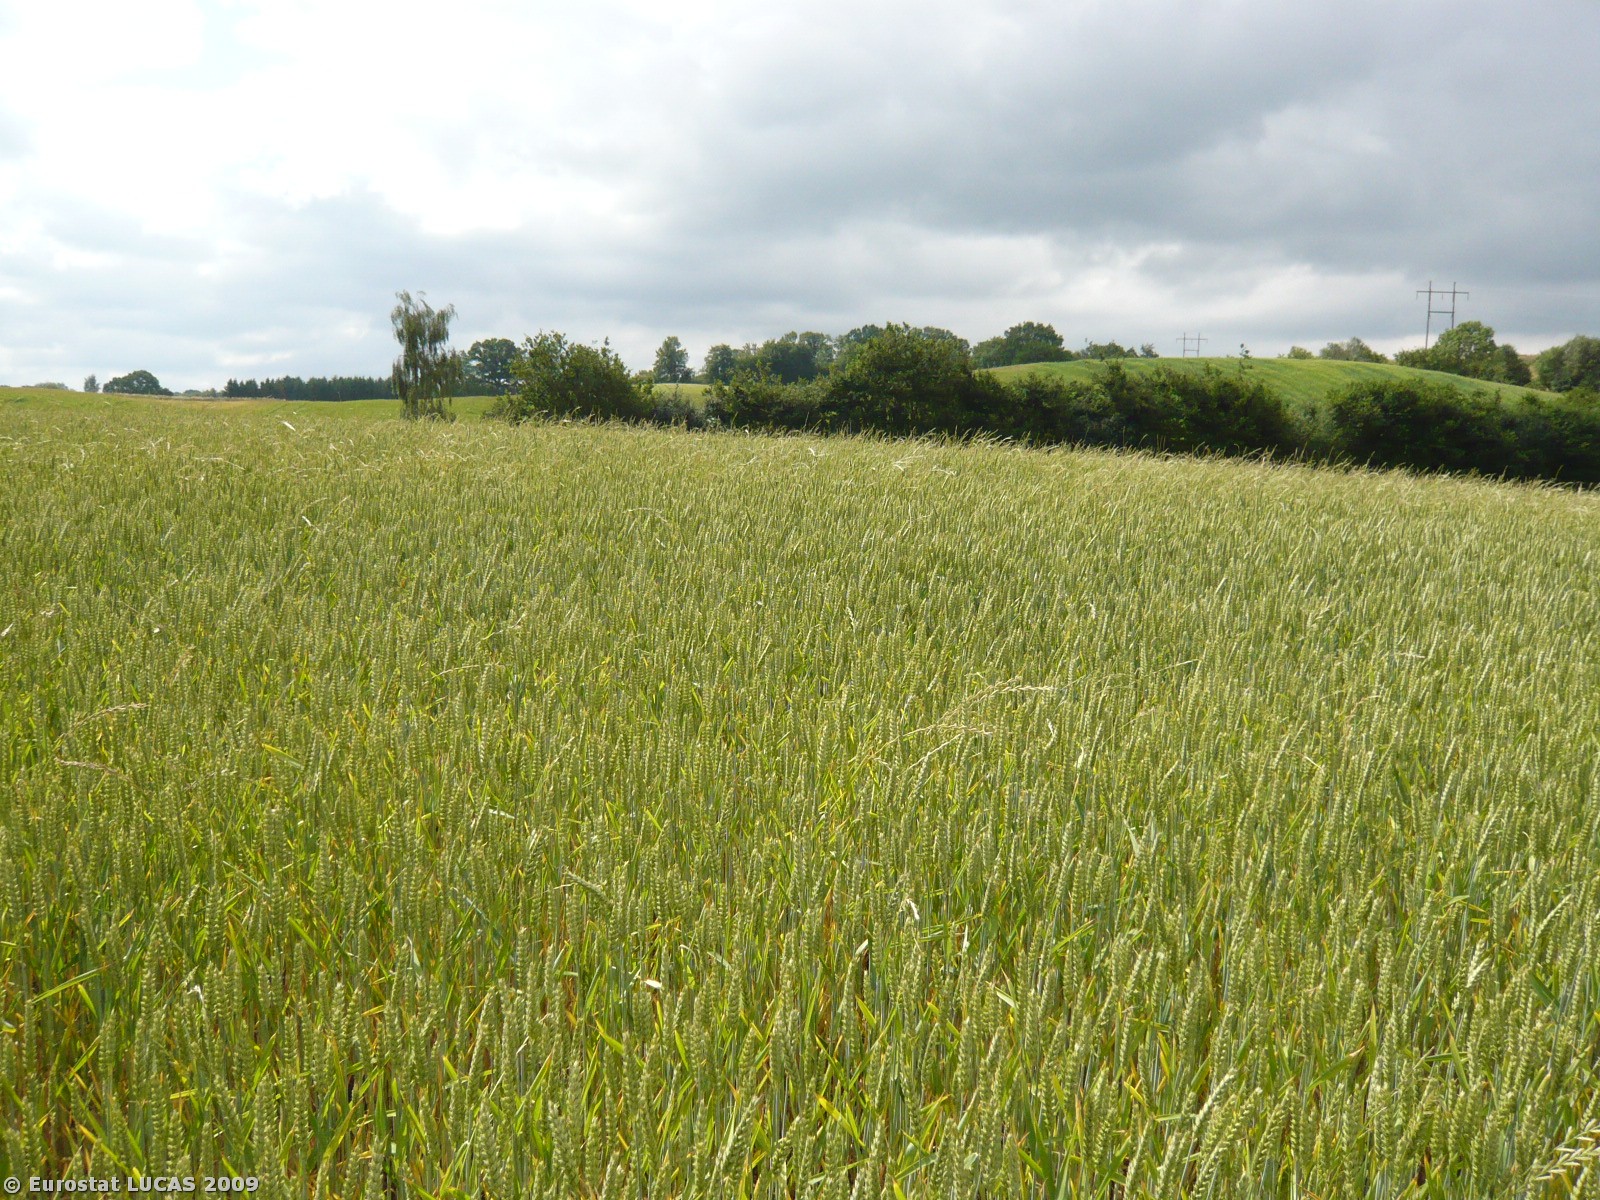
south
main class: Cropland
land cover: Common wheat
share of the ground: > 75 %
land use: Agriculture (excluding fallow land and kitchen gardens)
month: June
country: DK
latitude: 55.2709
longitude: 10.1730
